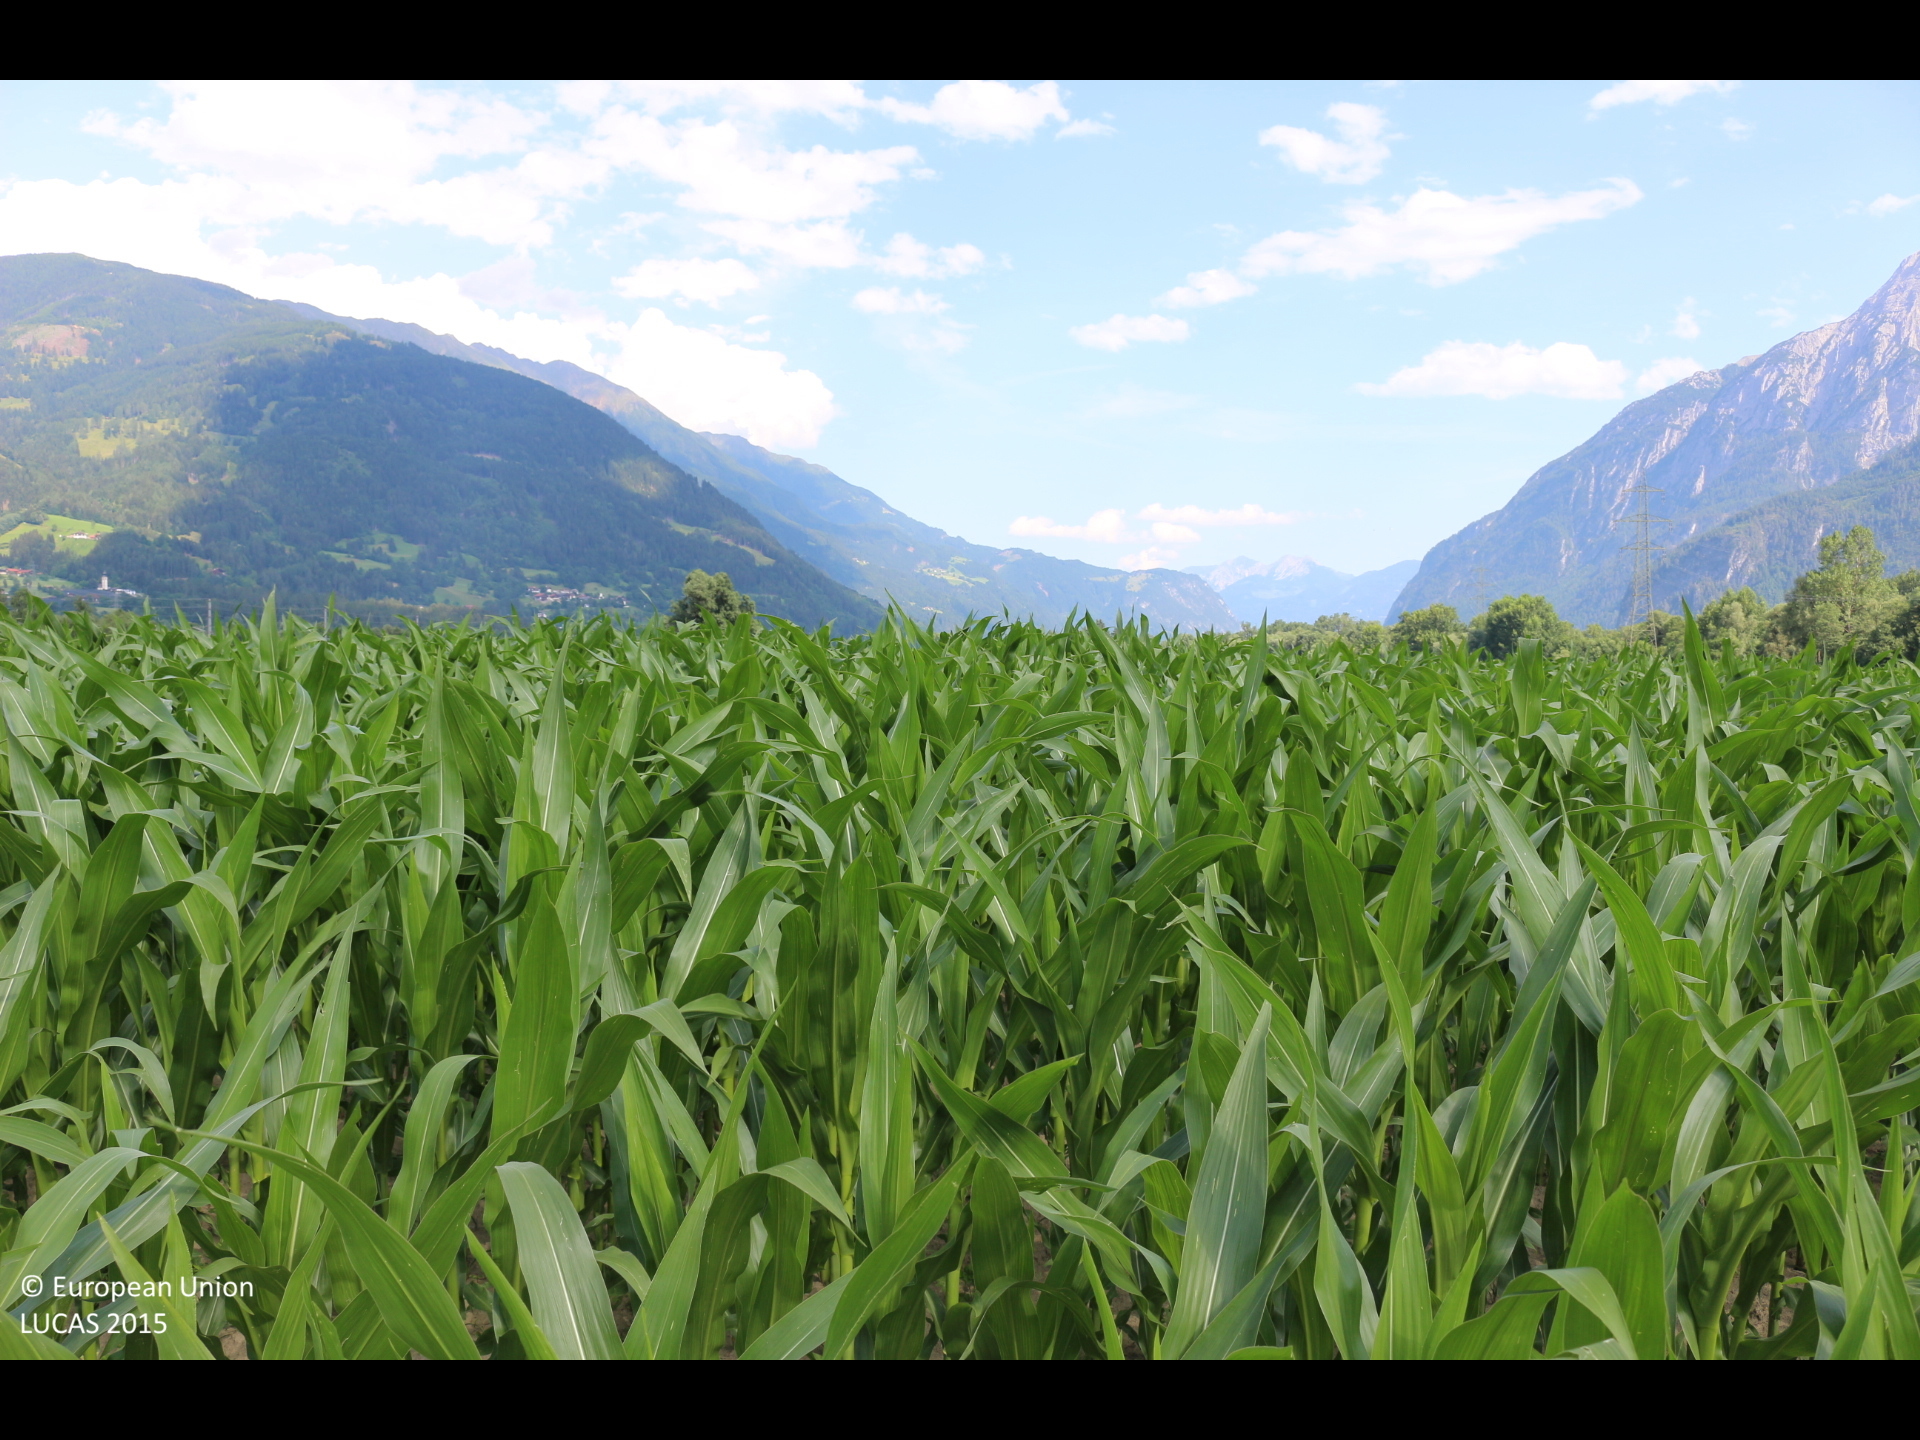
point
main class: Cropland
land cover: Maize
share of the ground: > 75 %
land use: Agriculture (excluding fallow land and kitchen gardens)
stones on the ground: < 10 %
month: July
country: AT
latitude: 46.8187
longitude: 12.8155
